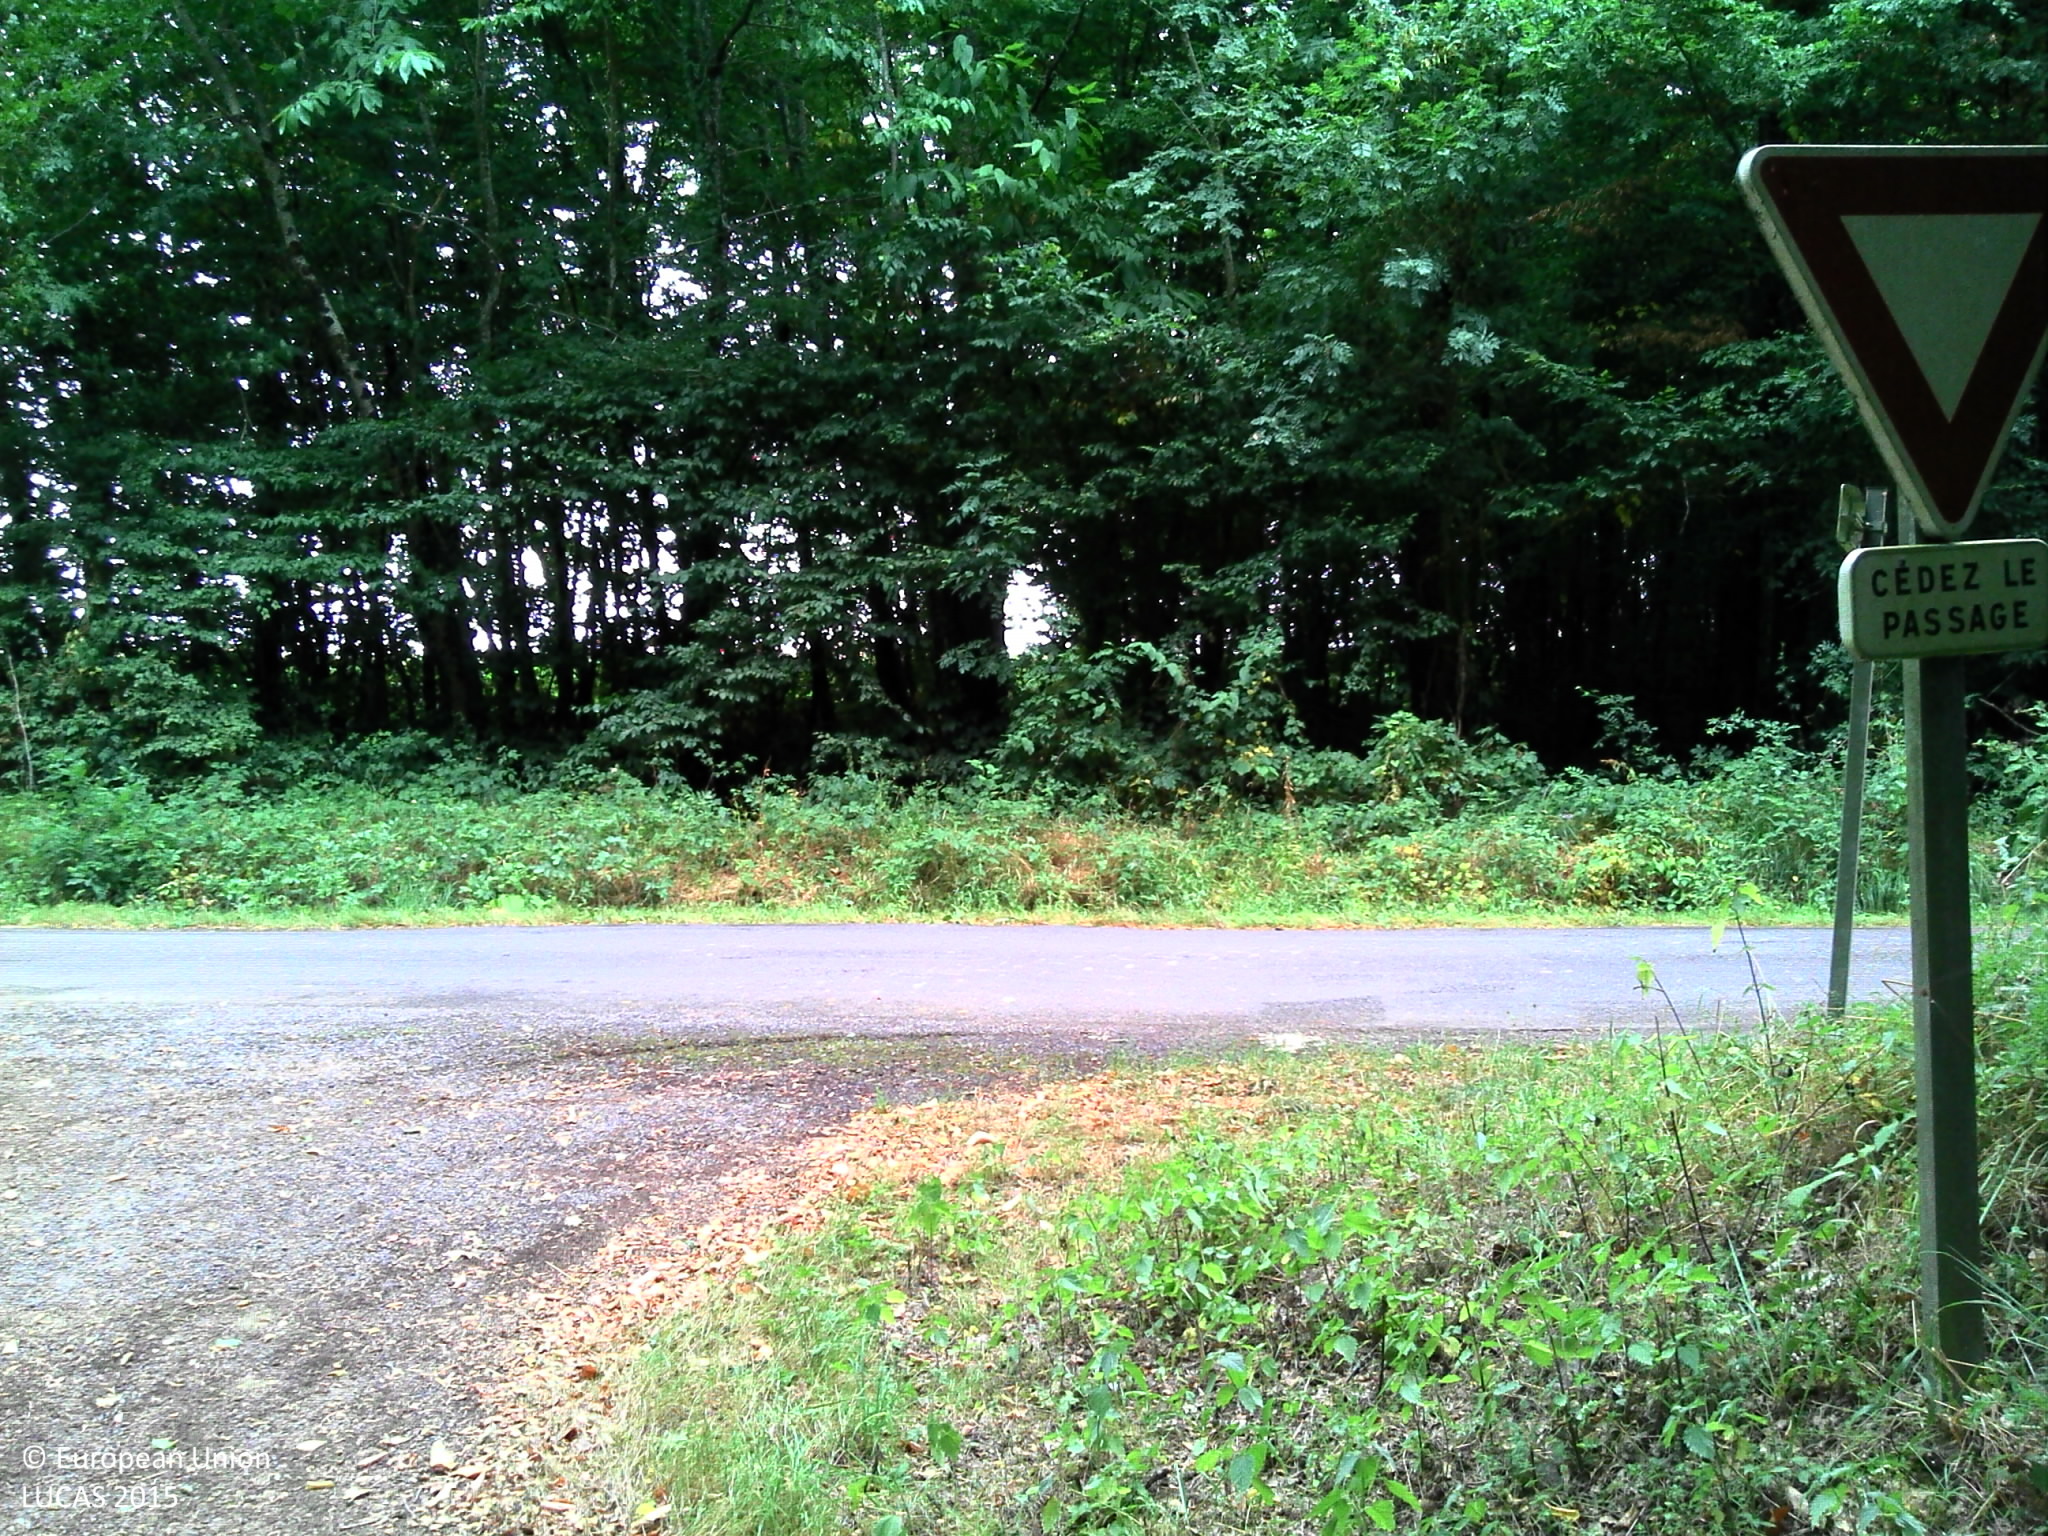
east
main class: Woodland
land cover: Broadleaved woodland
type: mesophytic deciduous forest
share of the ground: > 75 %
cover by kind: broadleaved forest trees 100 %
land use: Forestry
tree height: > 5 m
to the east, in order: Broadleaved woodland; Tracks; Pine dominated coniferous woodland
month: July
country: FR
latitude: 46.3828
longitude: 0.3208
